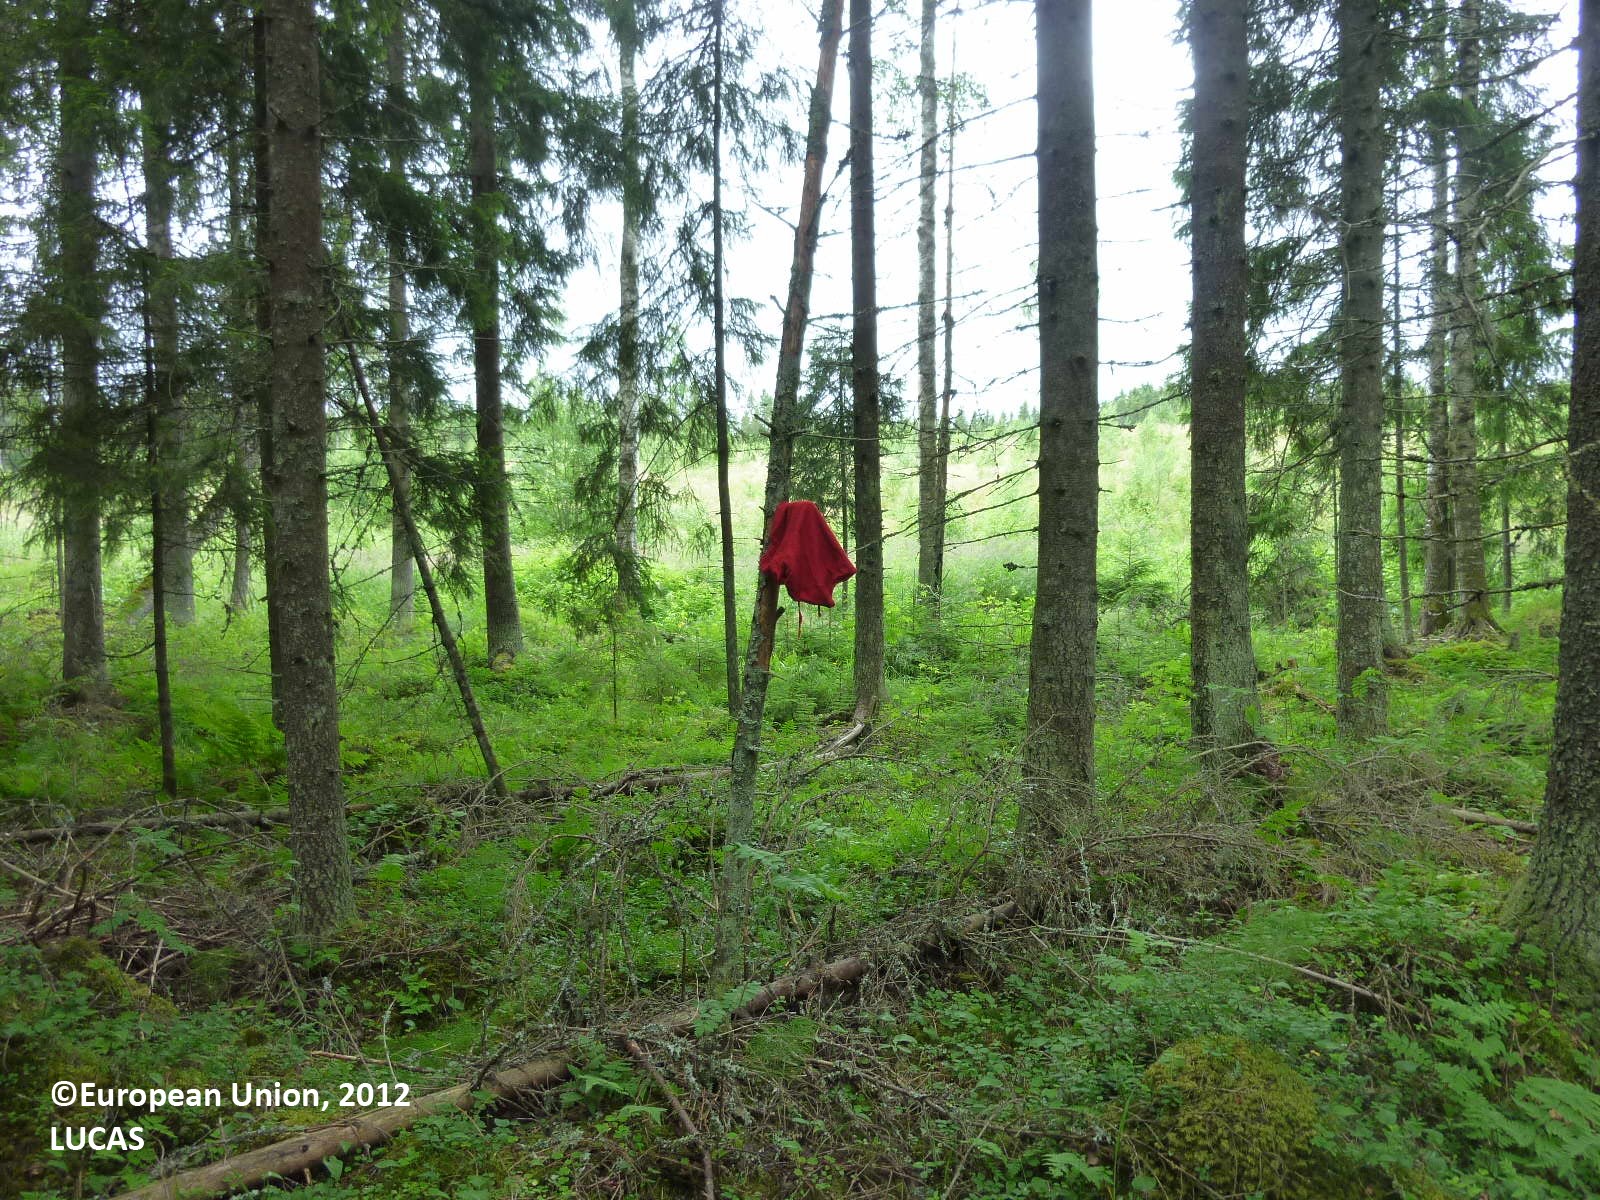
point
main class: Woodland
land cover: Spruce dominated coniferous woodland
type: boreal forest
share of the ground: > 75 %
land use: Forestry
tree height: > 5 m
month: July
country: FI
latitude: 61.7020
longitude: 22.1017
